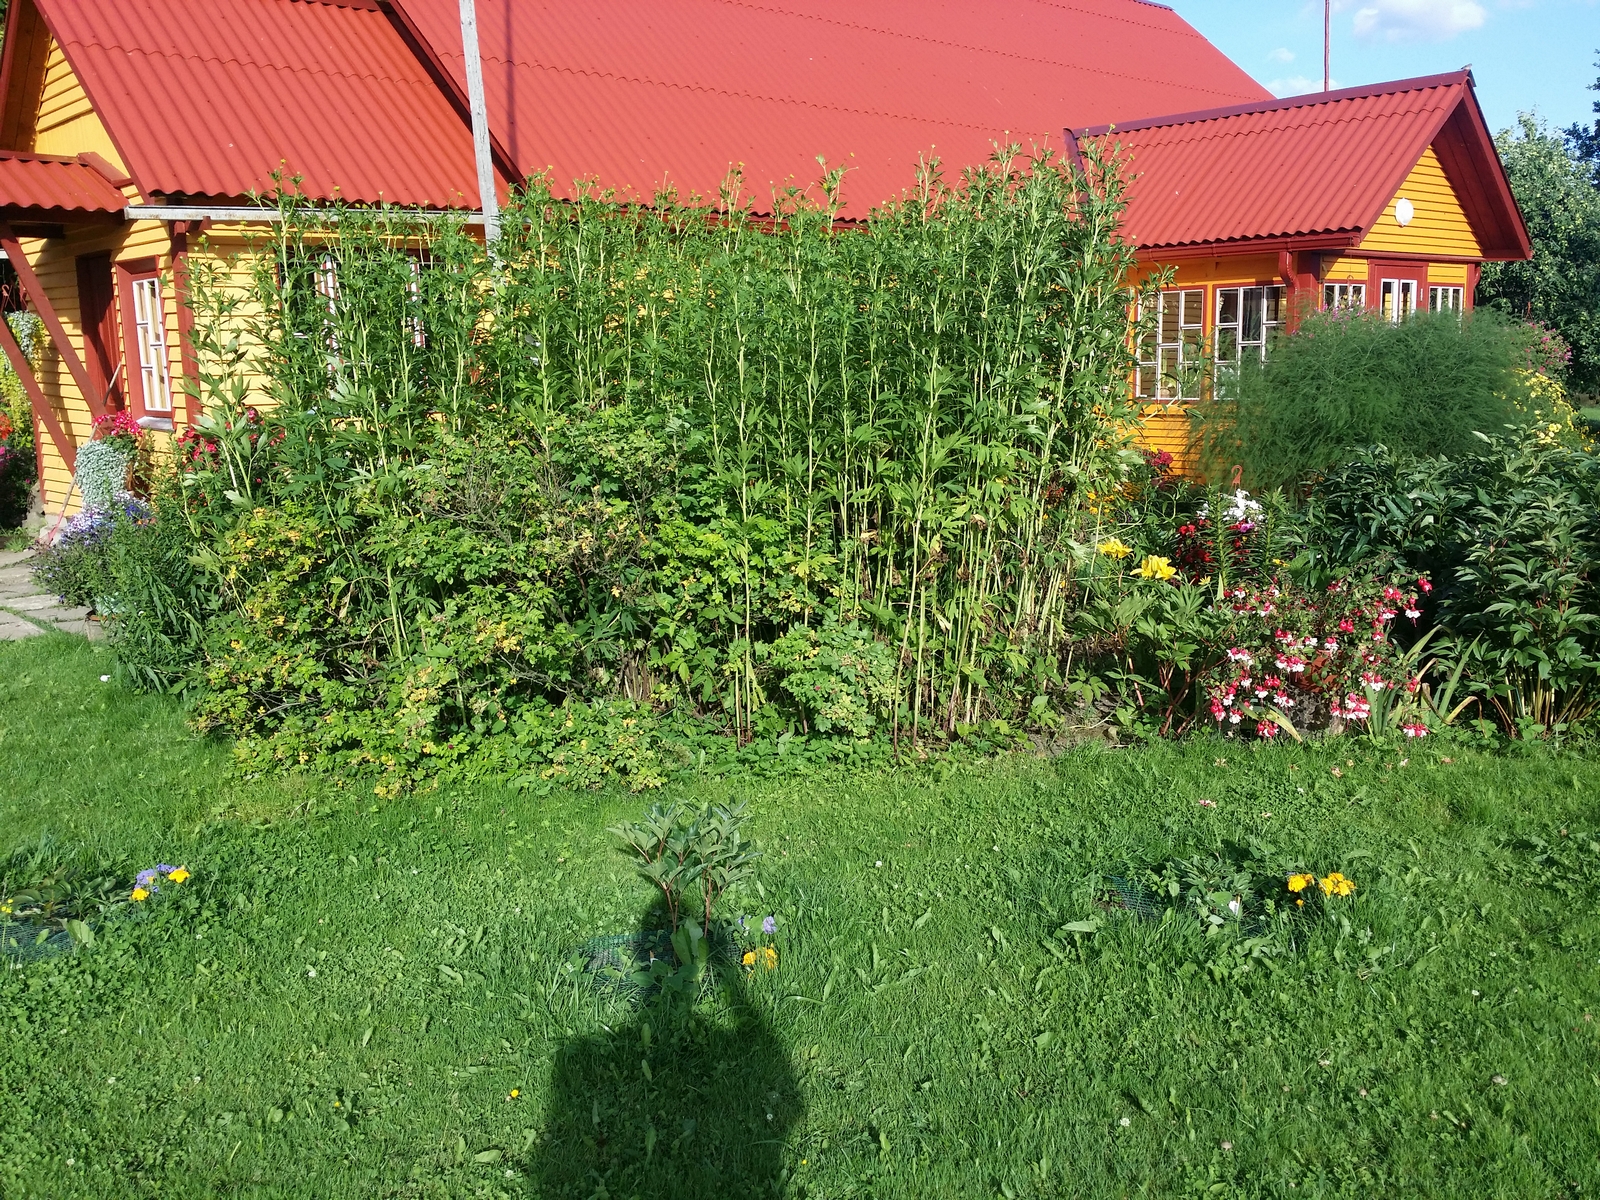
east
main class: Grassland
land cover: Grassland without tree/shrub cover
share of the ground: > 75 %
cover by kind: herbaceous plants 100 %
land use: Residential
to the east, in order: Grassland without tree/shrub cover; Artificial constructions in urban areas; Broadleaved woodland; Other fresh vegetables; Common wheat; Grass margins; Abandoned hedges; Ditches and canals; Paved roads, cycling and walking lanes; Shruby margins; Oats
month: July
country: LV
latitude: 57.1818
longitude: 27.2572
